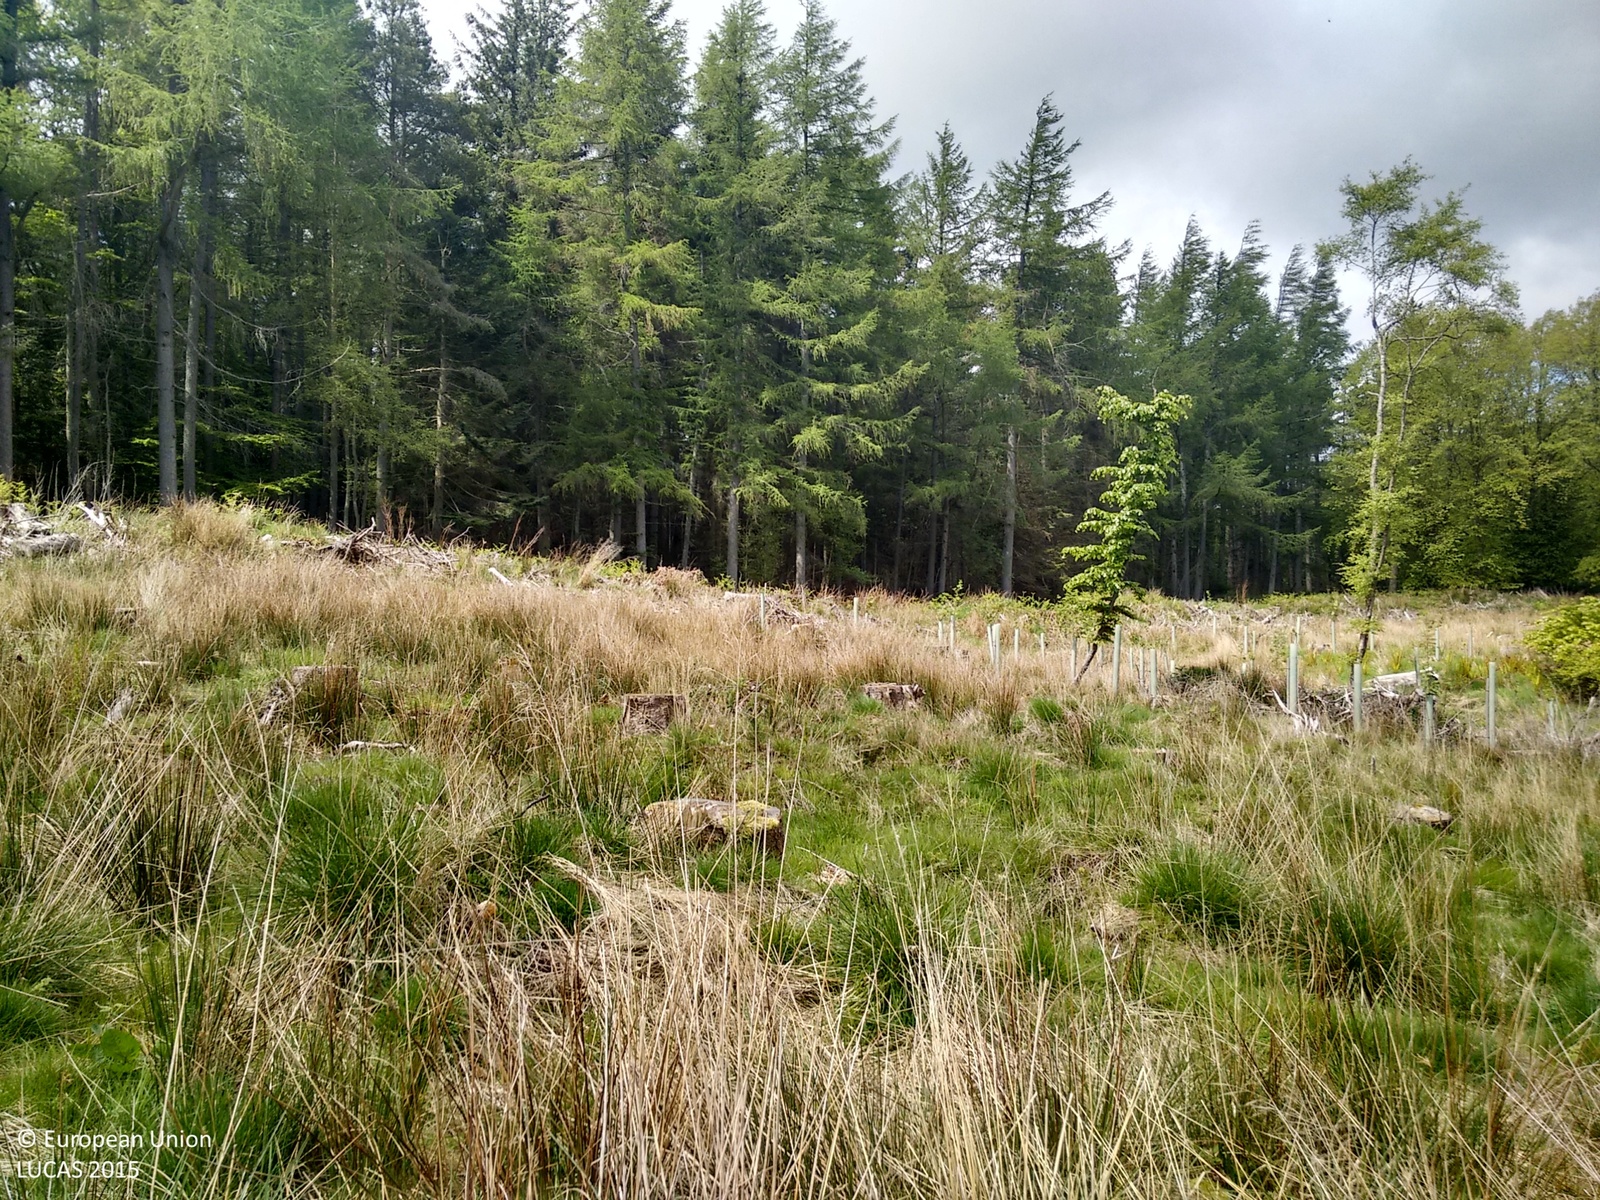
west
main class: Grassland
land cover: Grassland with sparse tree/shrub cover
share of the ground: > 75 %
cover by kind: herbaceous plants 85 %, broadleaved forest trees 5 %
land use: Forestry
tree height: > 5 m
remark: Clear cut
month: May
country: GB
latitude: 55.9380
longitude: -2.4985
